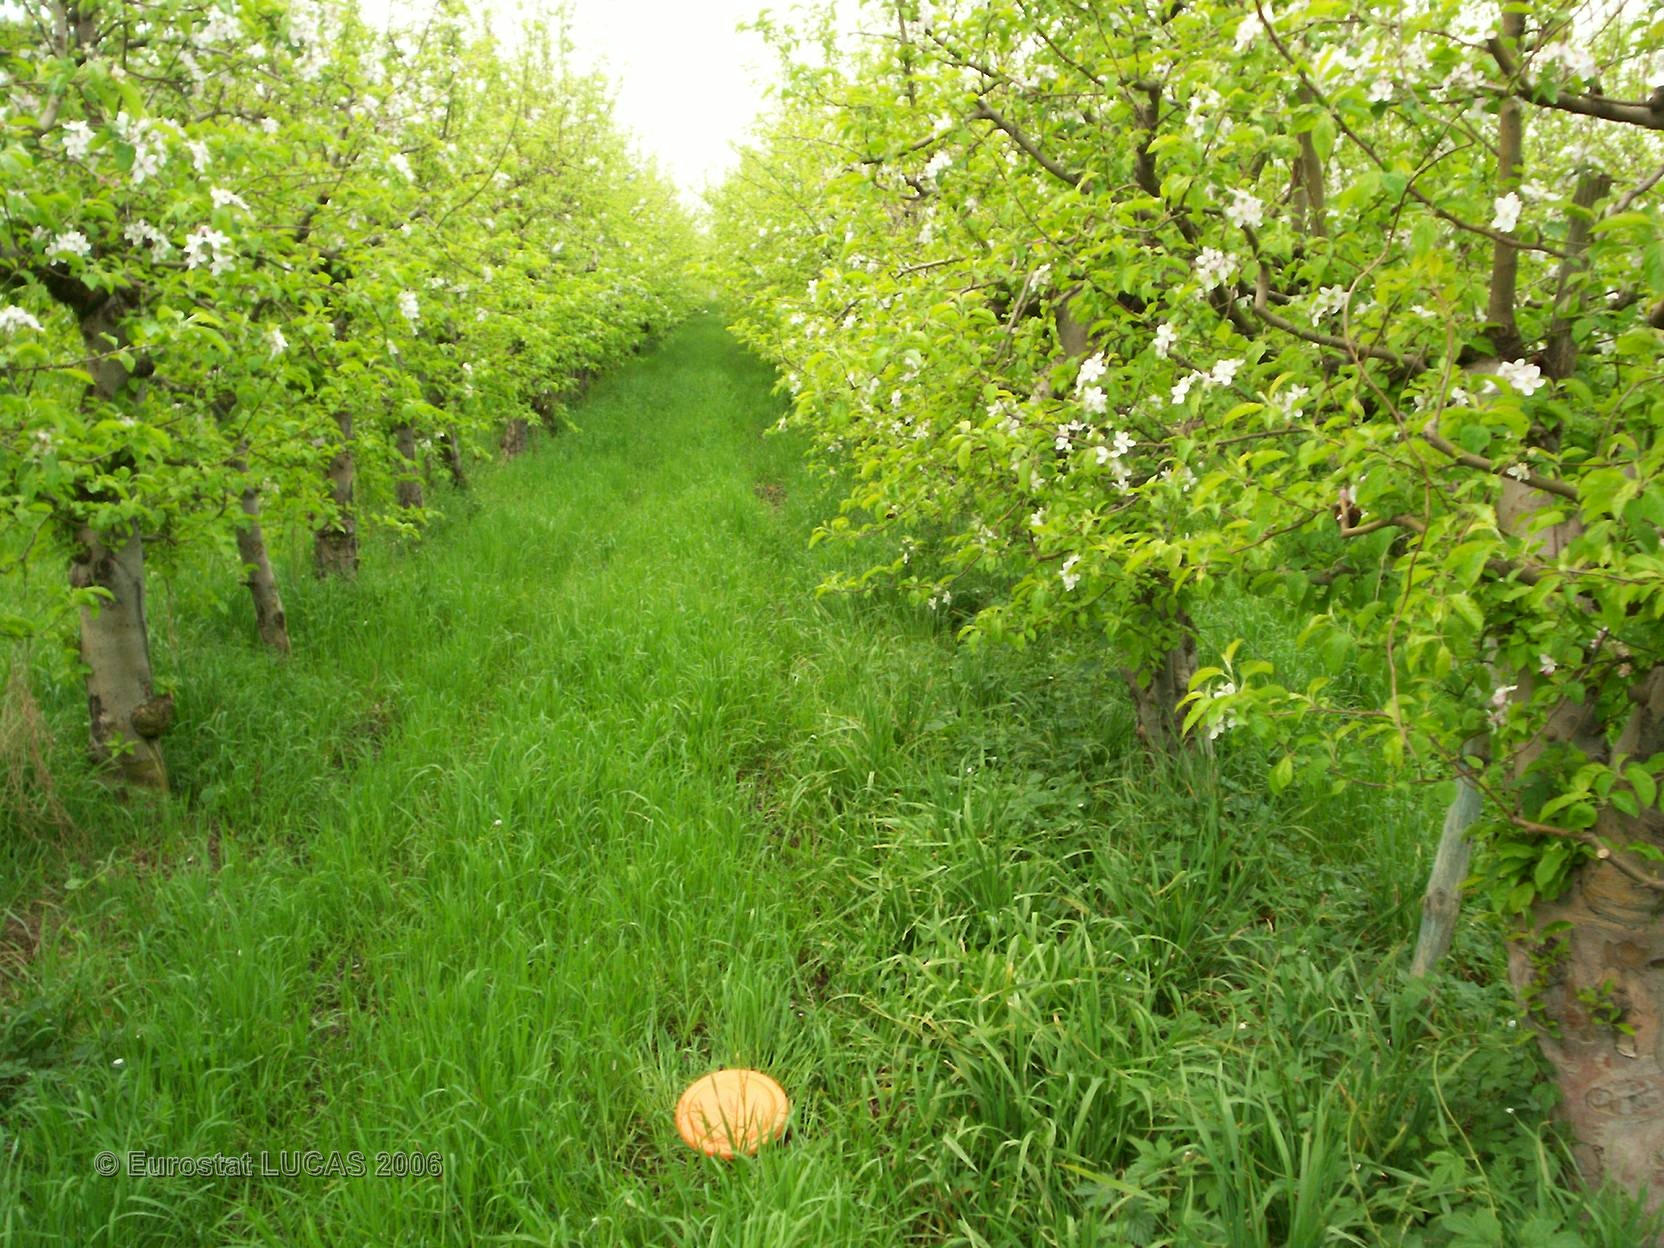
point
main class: Cropland
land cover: Apple fruit
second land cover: Grassland with sparse tree/shrub cover
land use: Agriculture (excluding fallow land and kitchen gardens)
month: April
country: FR
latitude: 43.8095
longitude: 4.8998
